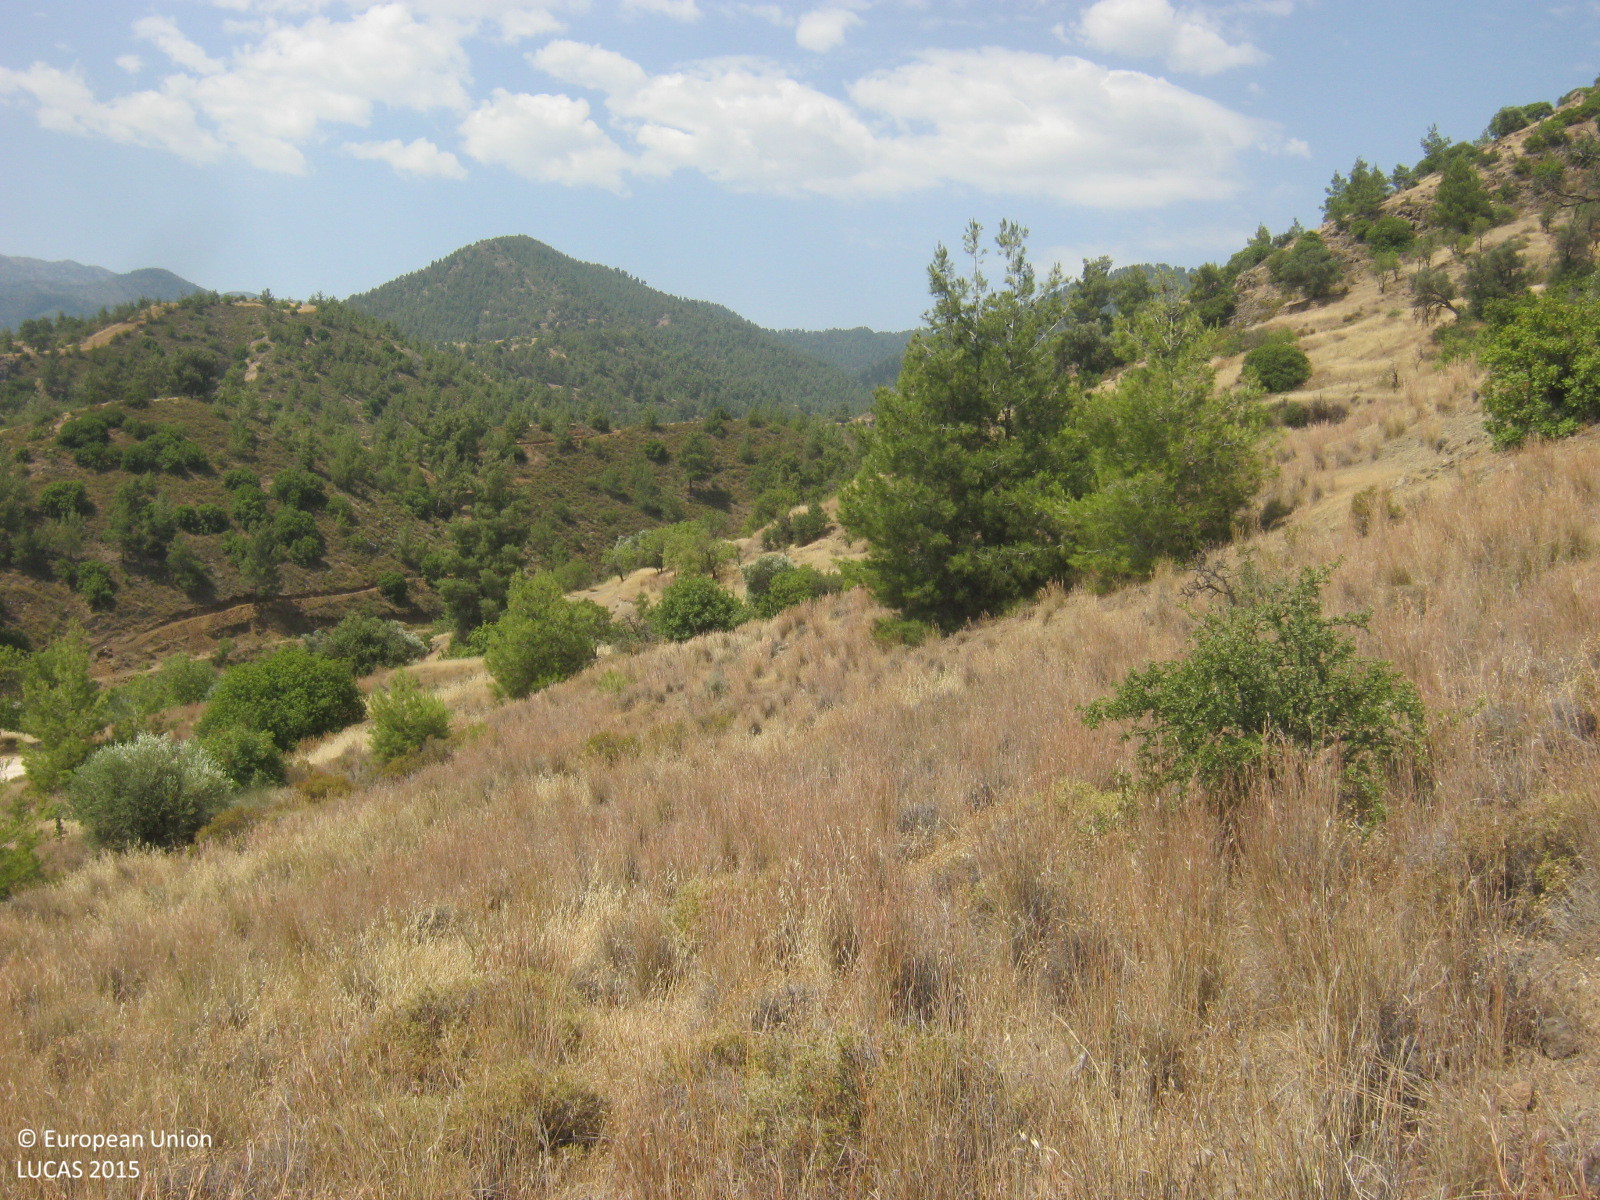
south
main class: Shrubland
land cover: Shrubland without tree cover
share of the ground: 10 - 25 %
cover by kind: herbaceous plants 70 %, shrubs 25 %, unconsolidated bare surface 5 %
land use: Semi-natural and natural areas not in use
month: June
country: CY
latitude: 35.0357
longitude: 33.0082
